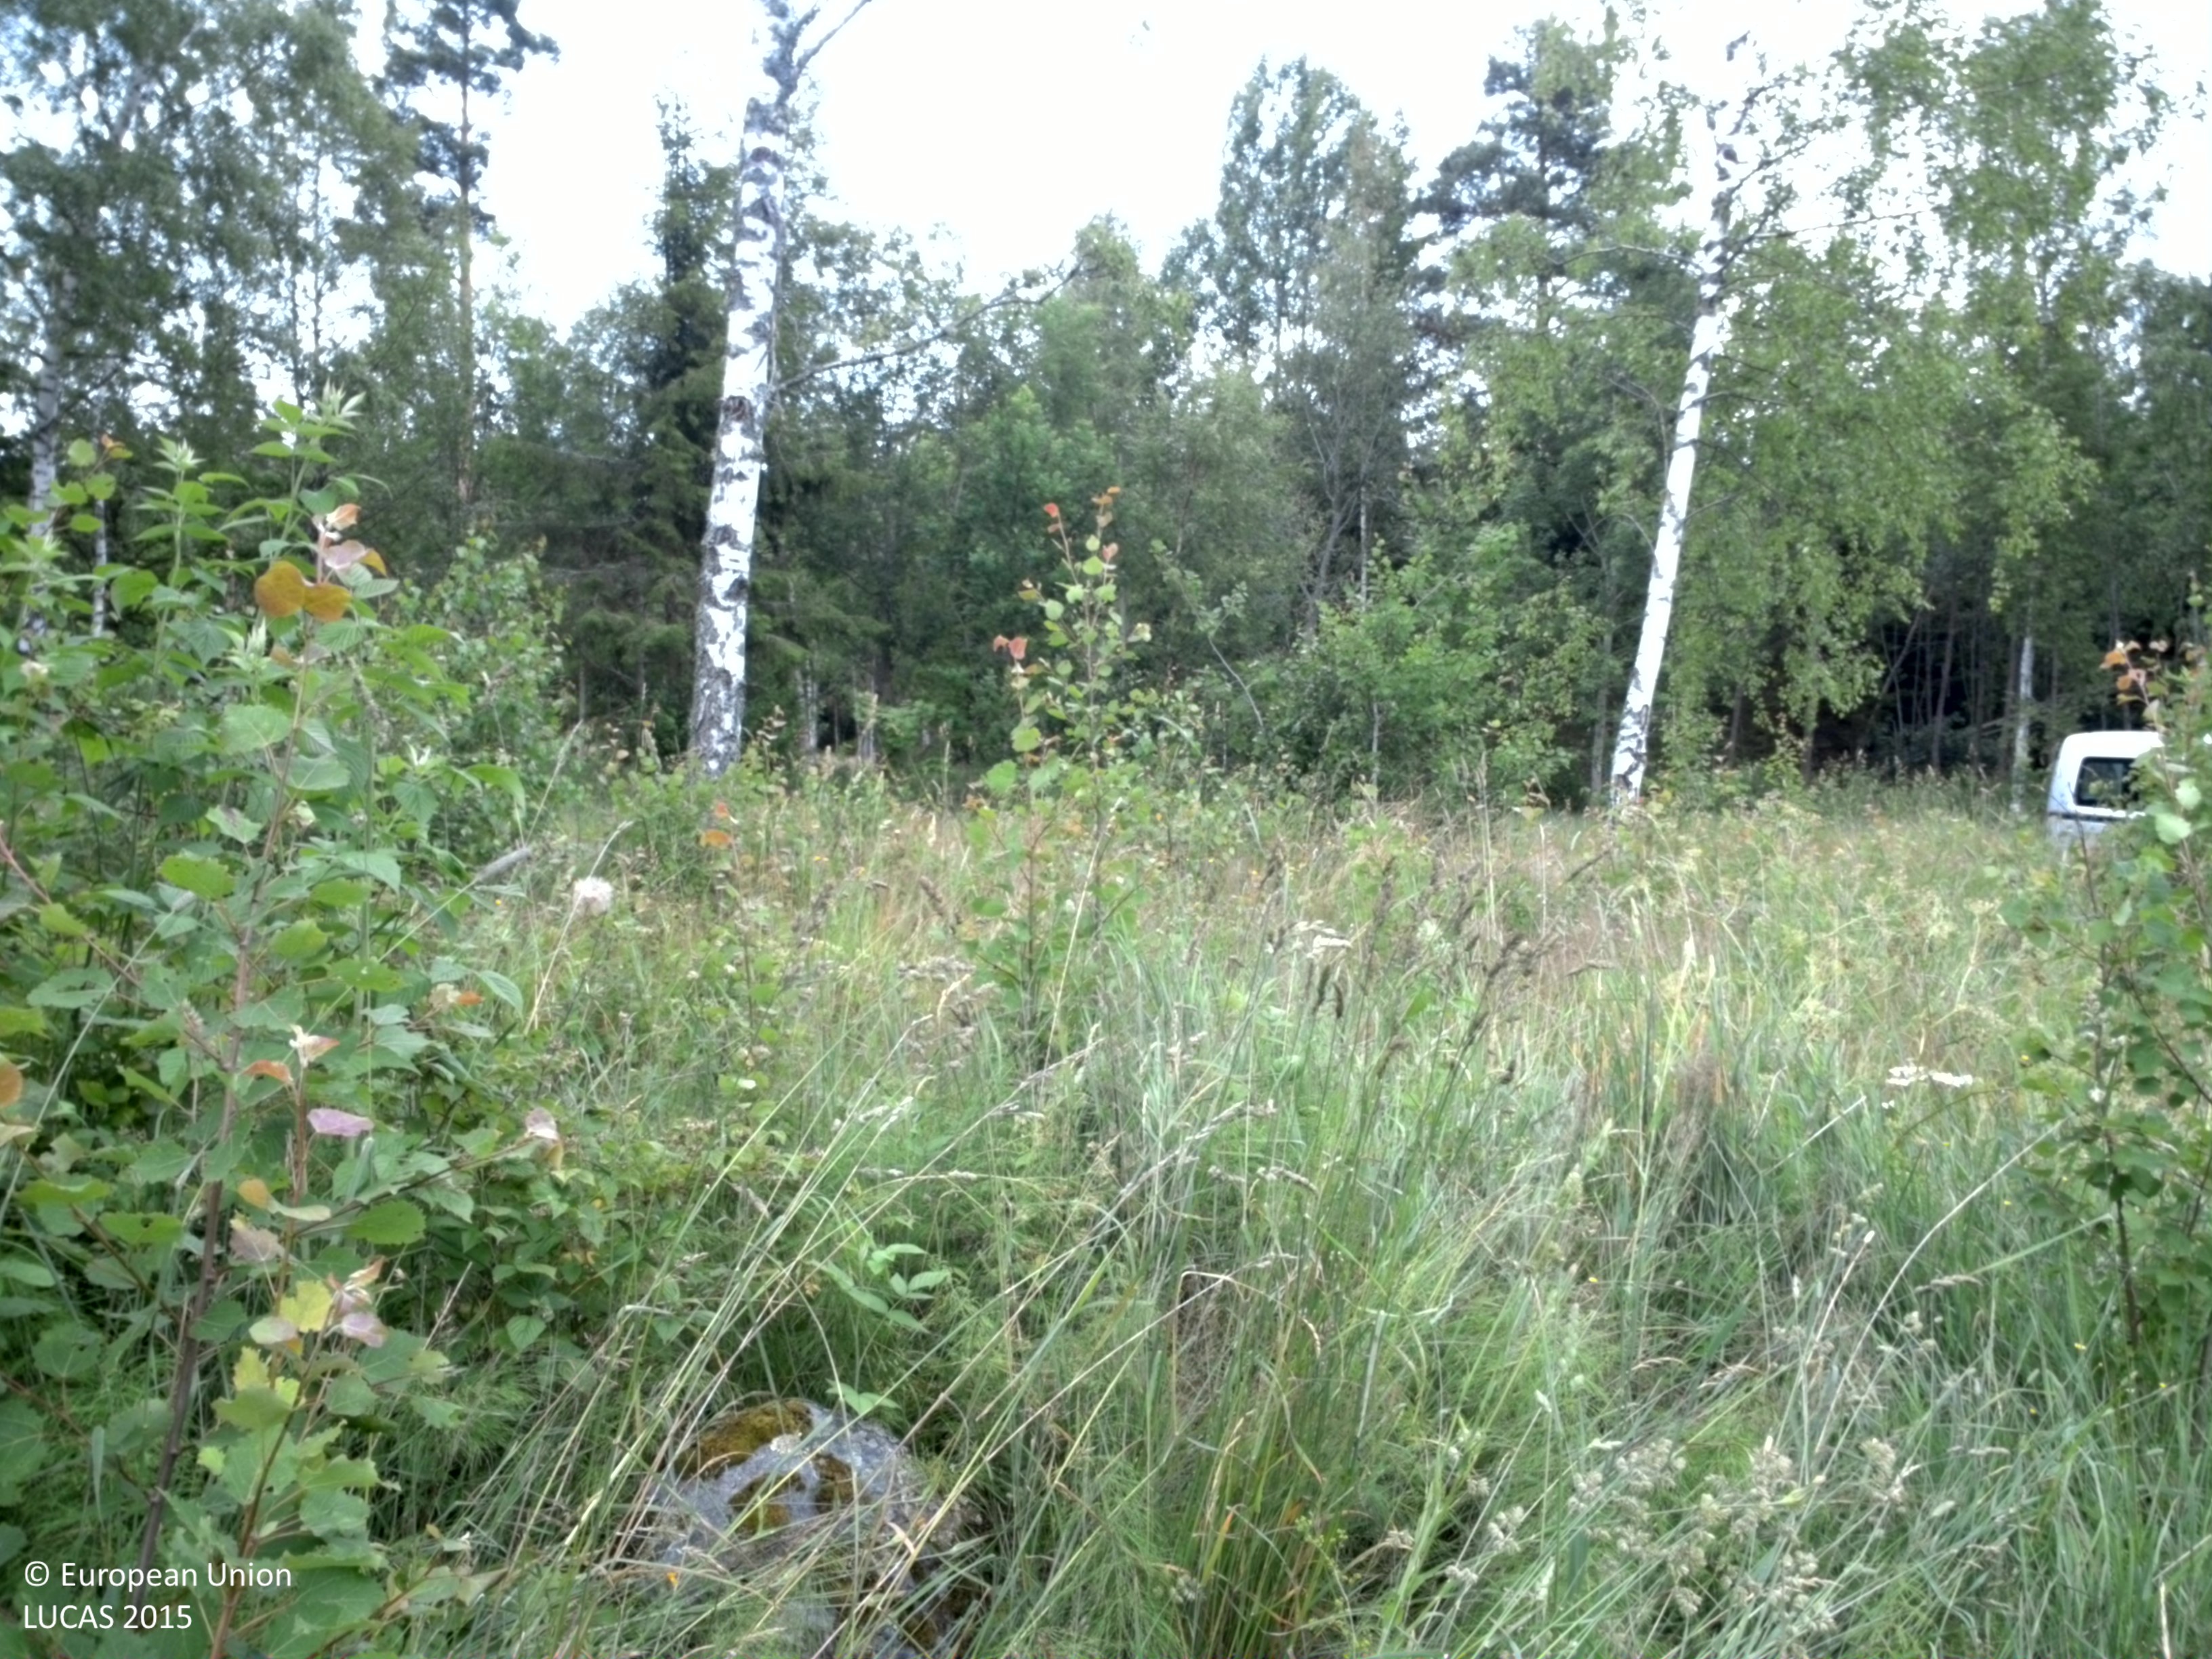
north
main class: Grassland
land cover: Grassland without tree/shrub cover
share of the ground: > 75 %
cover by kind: herbaceous plants 100 %
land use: Agriculture (excluding fallow land and kitchen gardens)
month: July
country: SE
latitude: 58.1424
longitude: 13.9862
